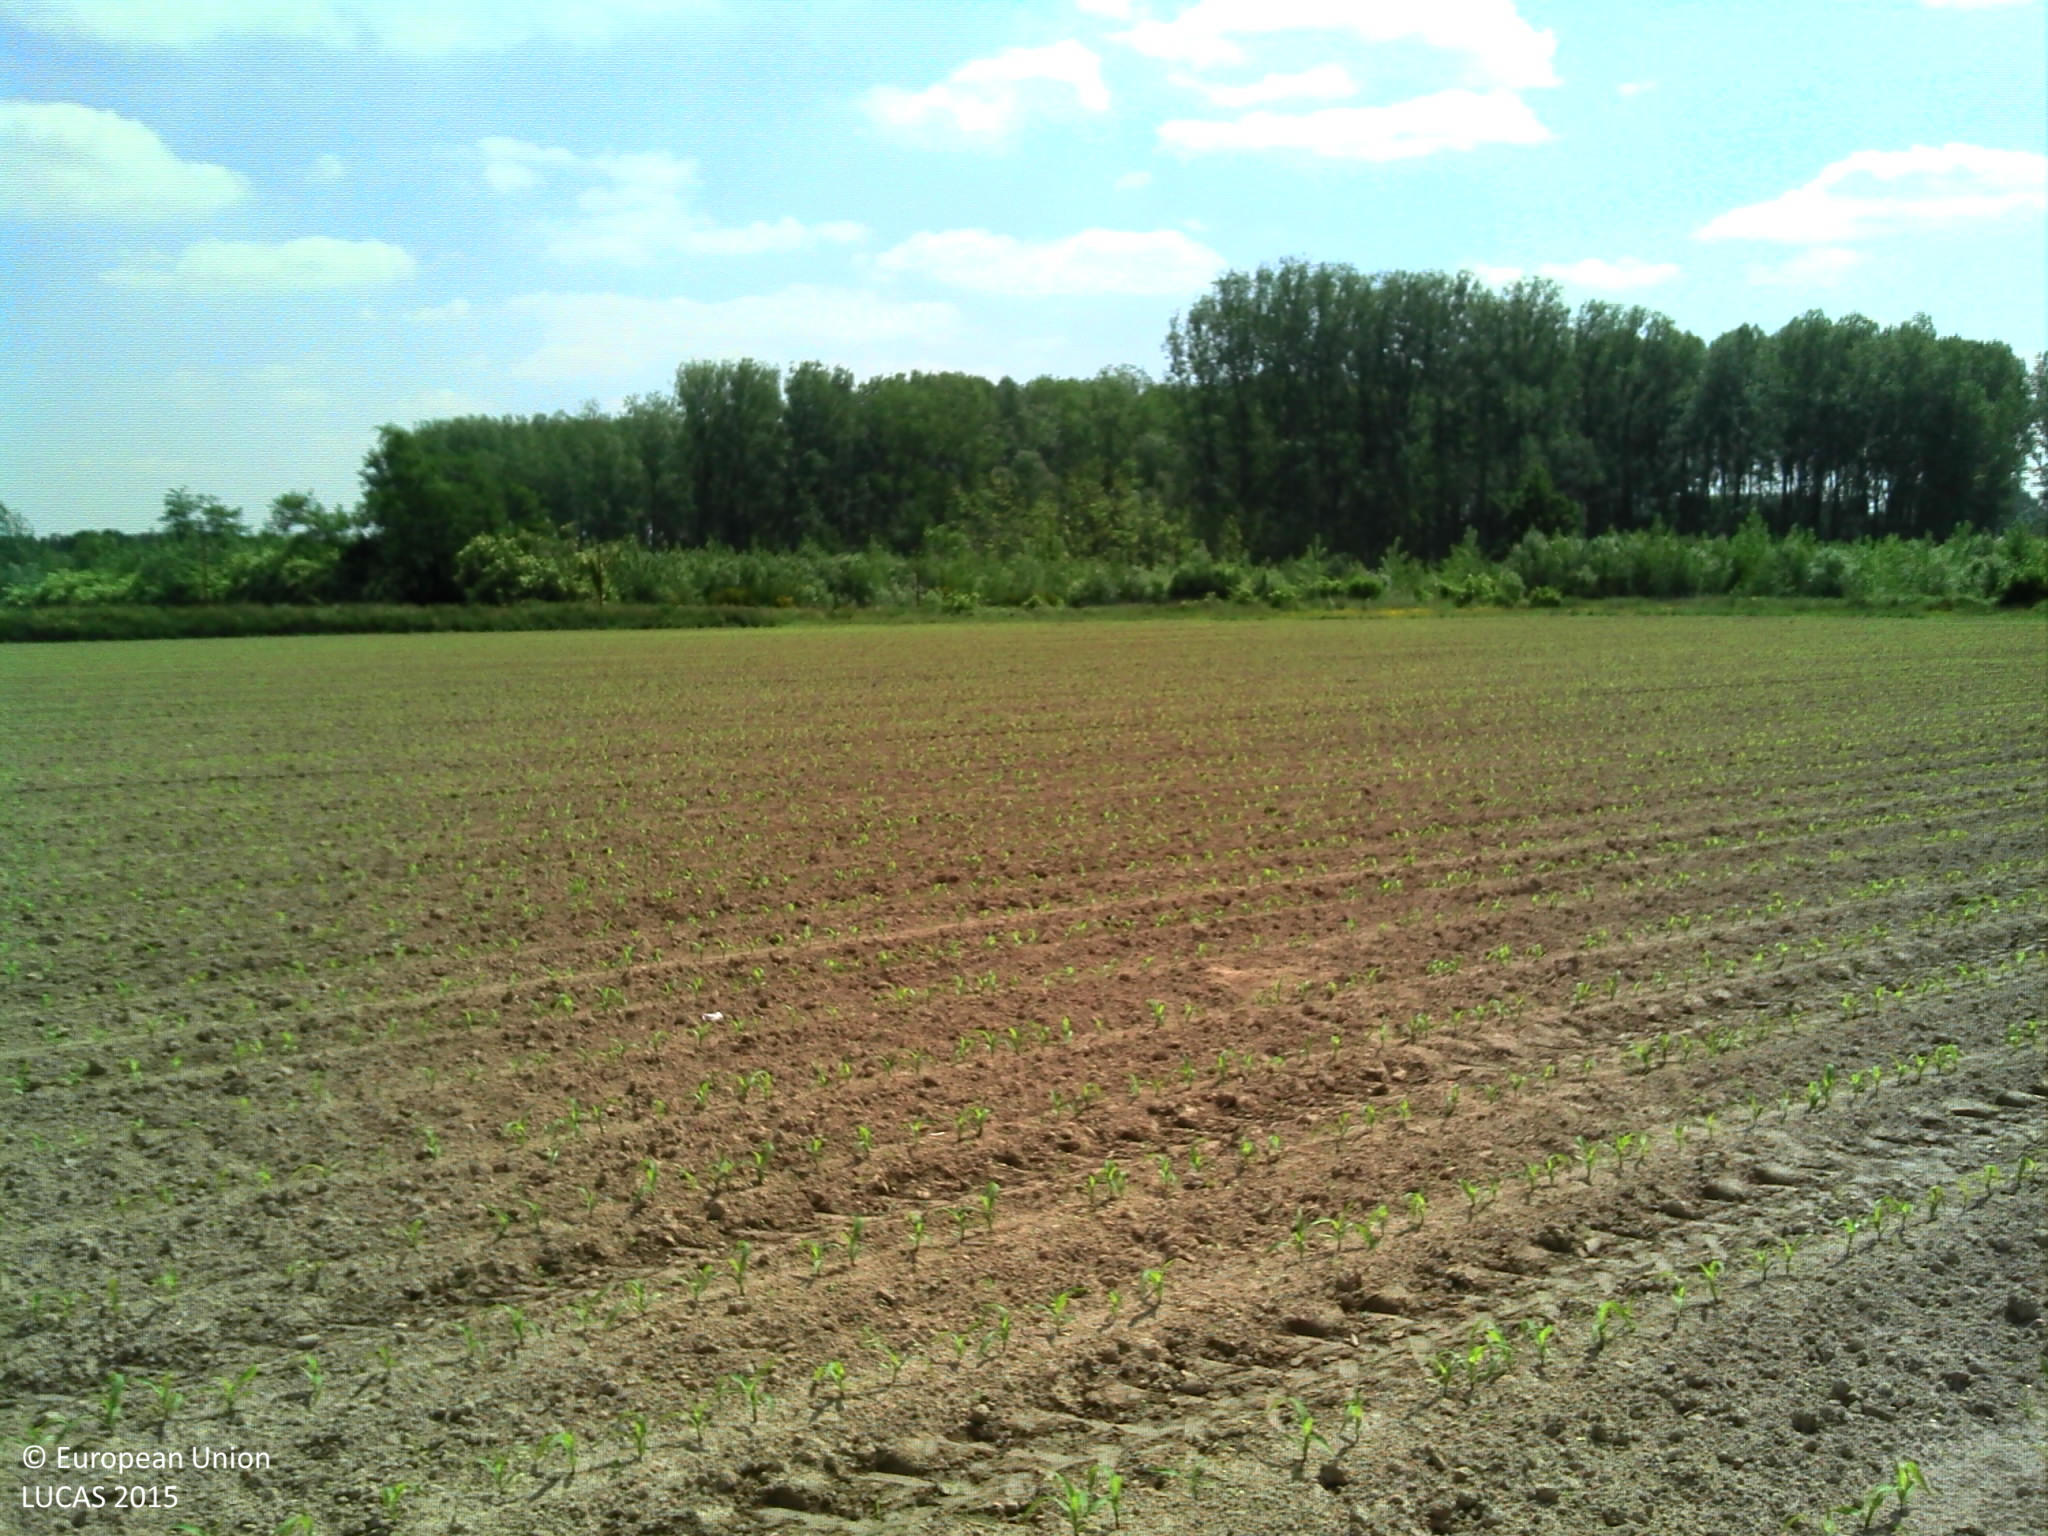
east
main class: Cropland
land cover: Maize
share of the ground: < 10 %
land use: Agriculture (excluding fallow land and kitchen gardens)
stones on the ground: < 10 %
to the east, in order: Maize; Grass margins; Tracks; Grass margins; Broadleaved woodland; Ditches and canals; Broadleaved woodland
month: June
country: BE
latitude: 50.9370
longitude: 3.8318
